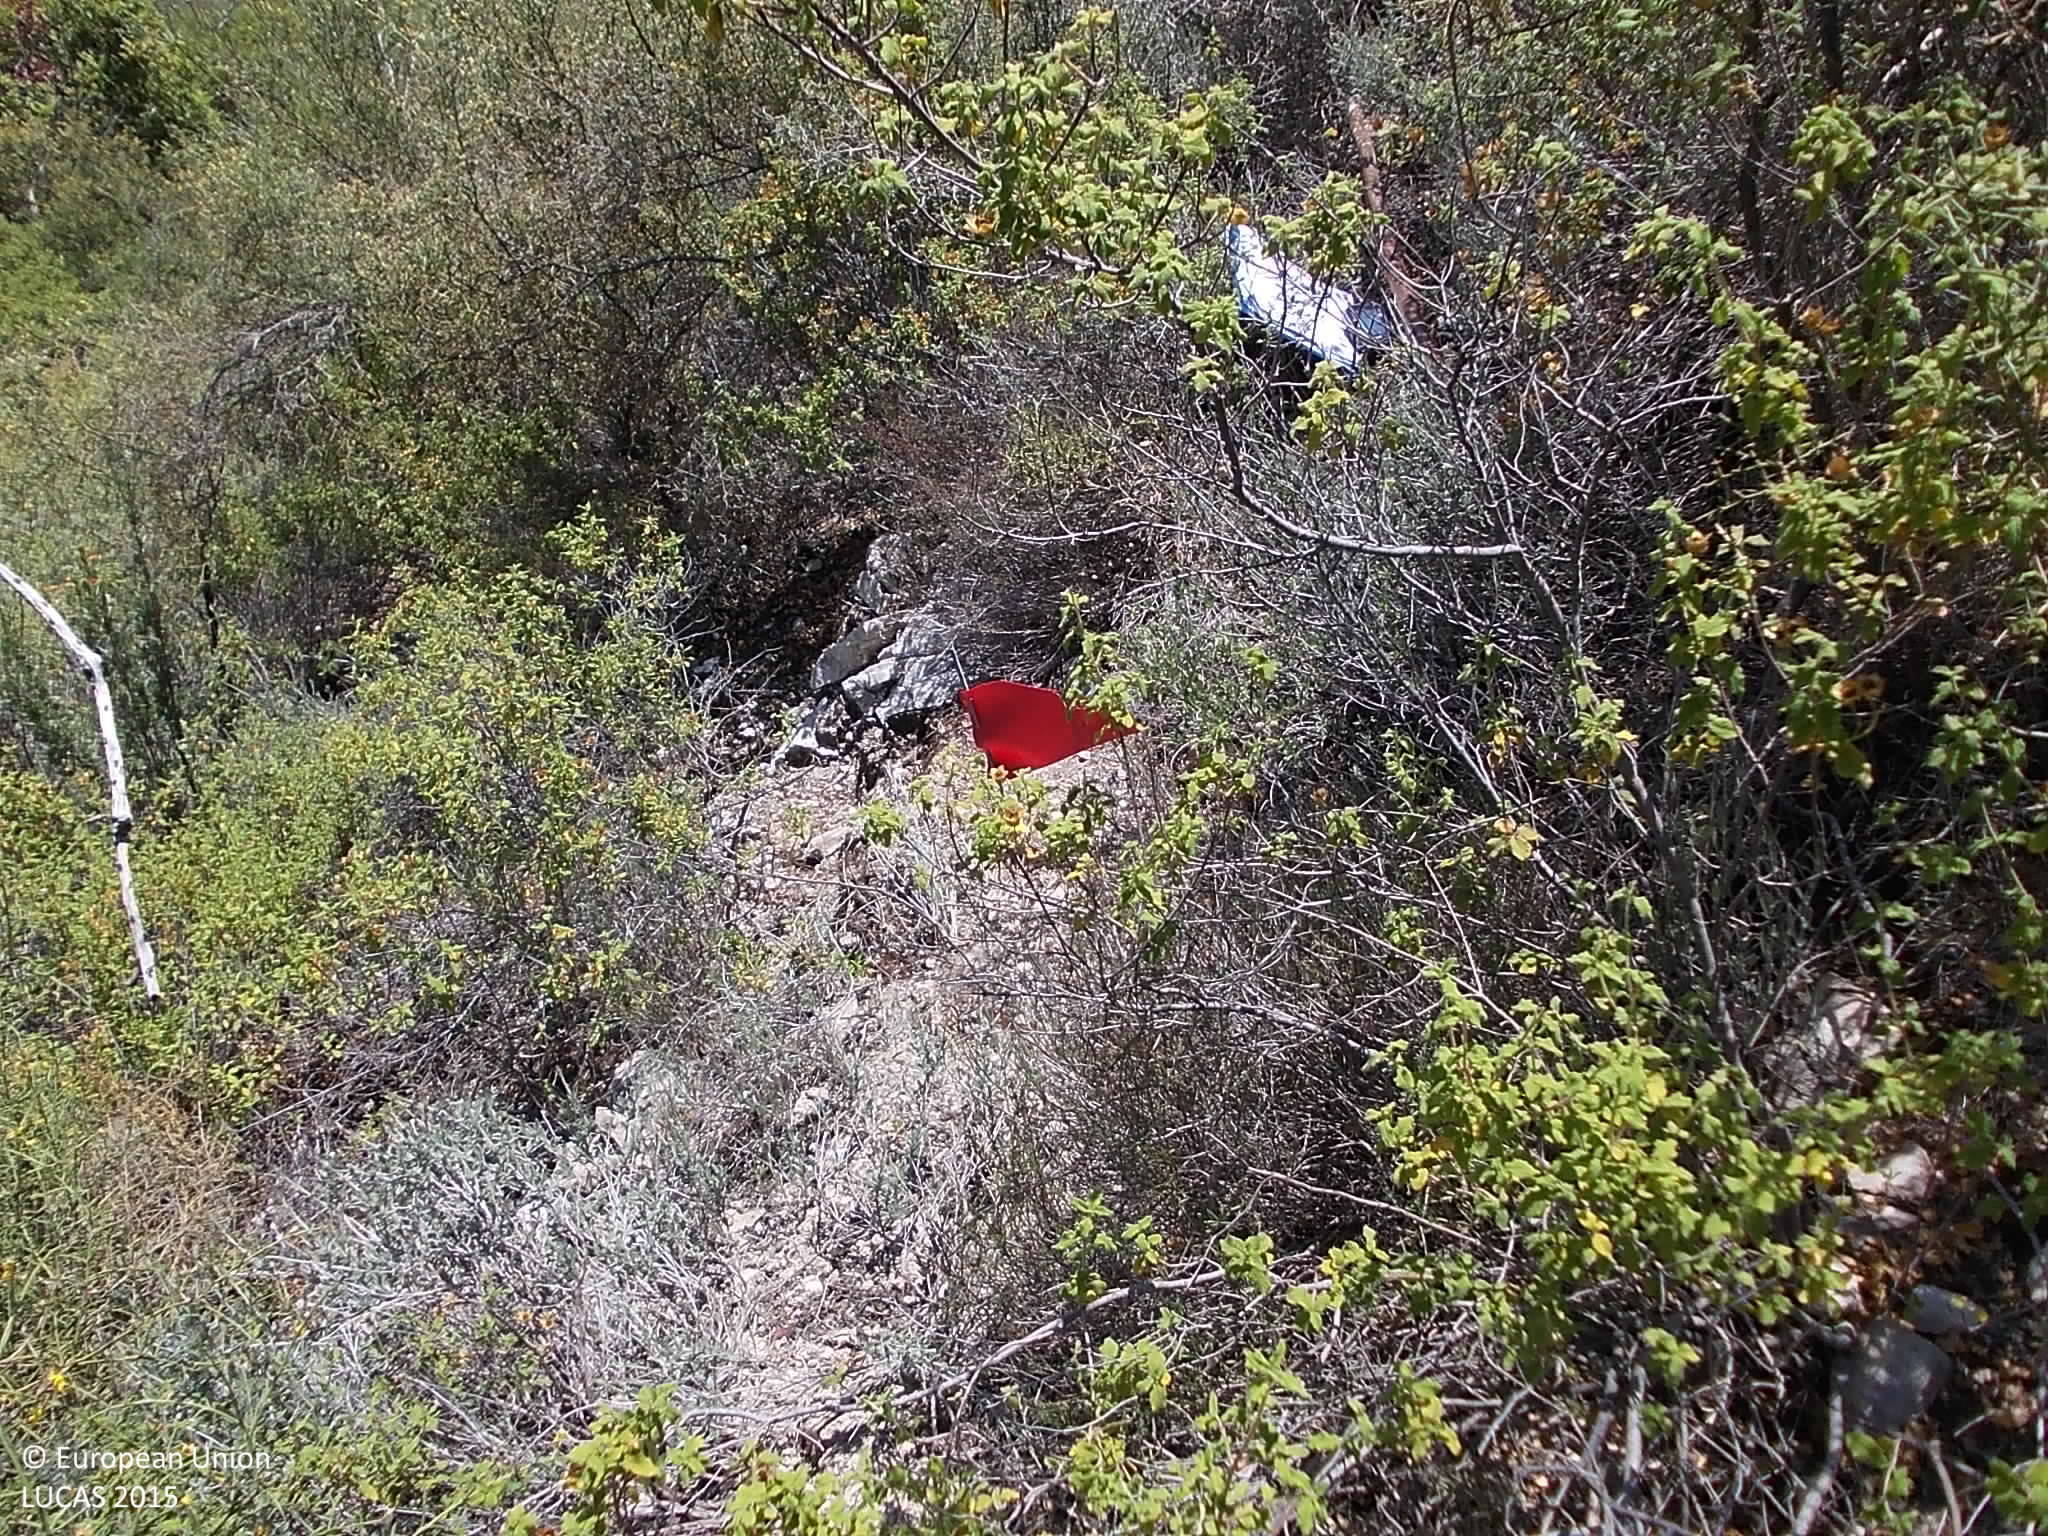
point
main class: Shrubland
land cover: Shrubland without tree cover
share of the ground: > 75 %
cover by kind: shrubs 95 %, unconsolidated bare surface 5 %
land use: Semi-natural and natural areas not in use
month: June
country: CY
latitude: 34.7238
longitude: 32.9078
